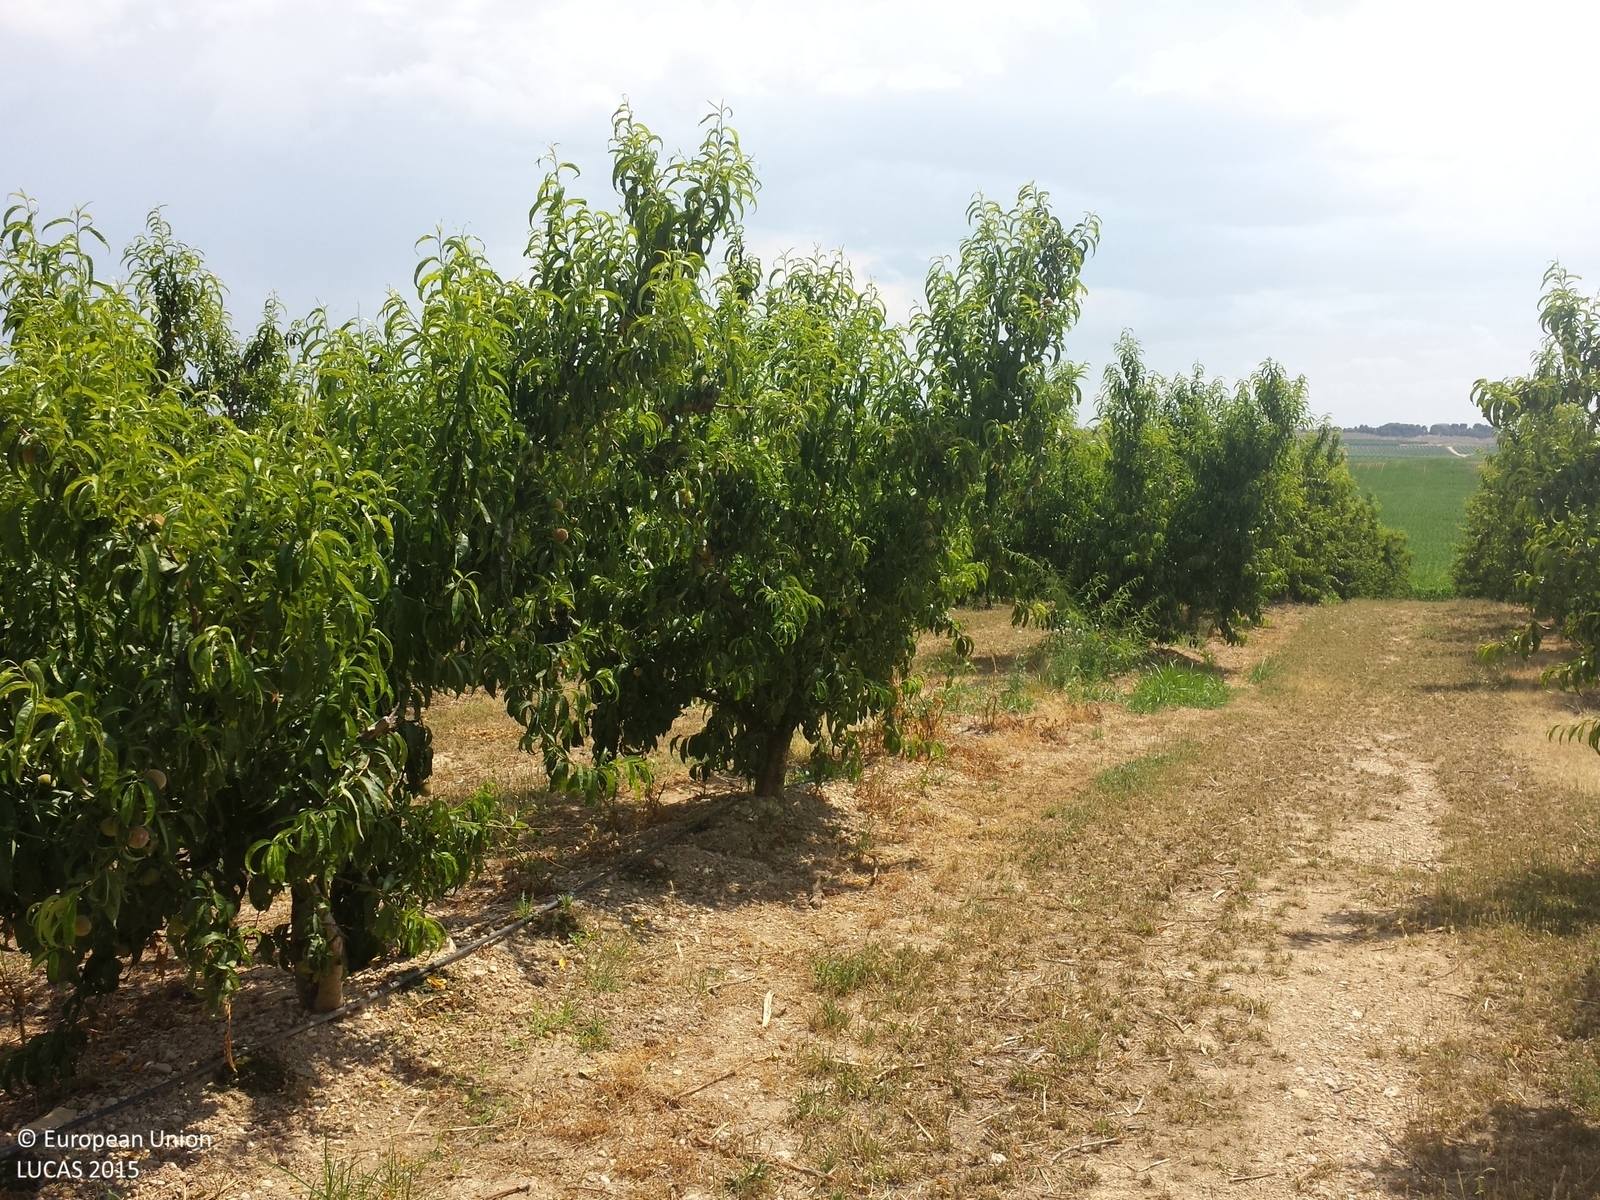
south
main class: Cropland
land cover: Other fruit trees and berries
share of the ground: 25 - 50 %
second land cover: Spontaneously vegetated surfaces
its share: 50 - 75 %
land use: Agriculture (excluding fallow land and kitchen gardens)
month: June
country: ES
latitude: 41.5392
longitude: 0.5544
